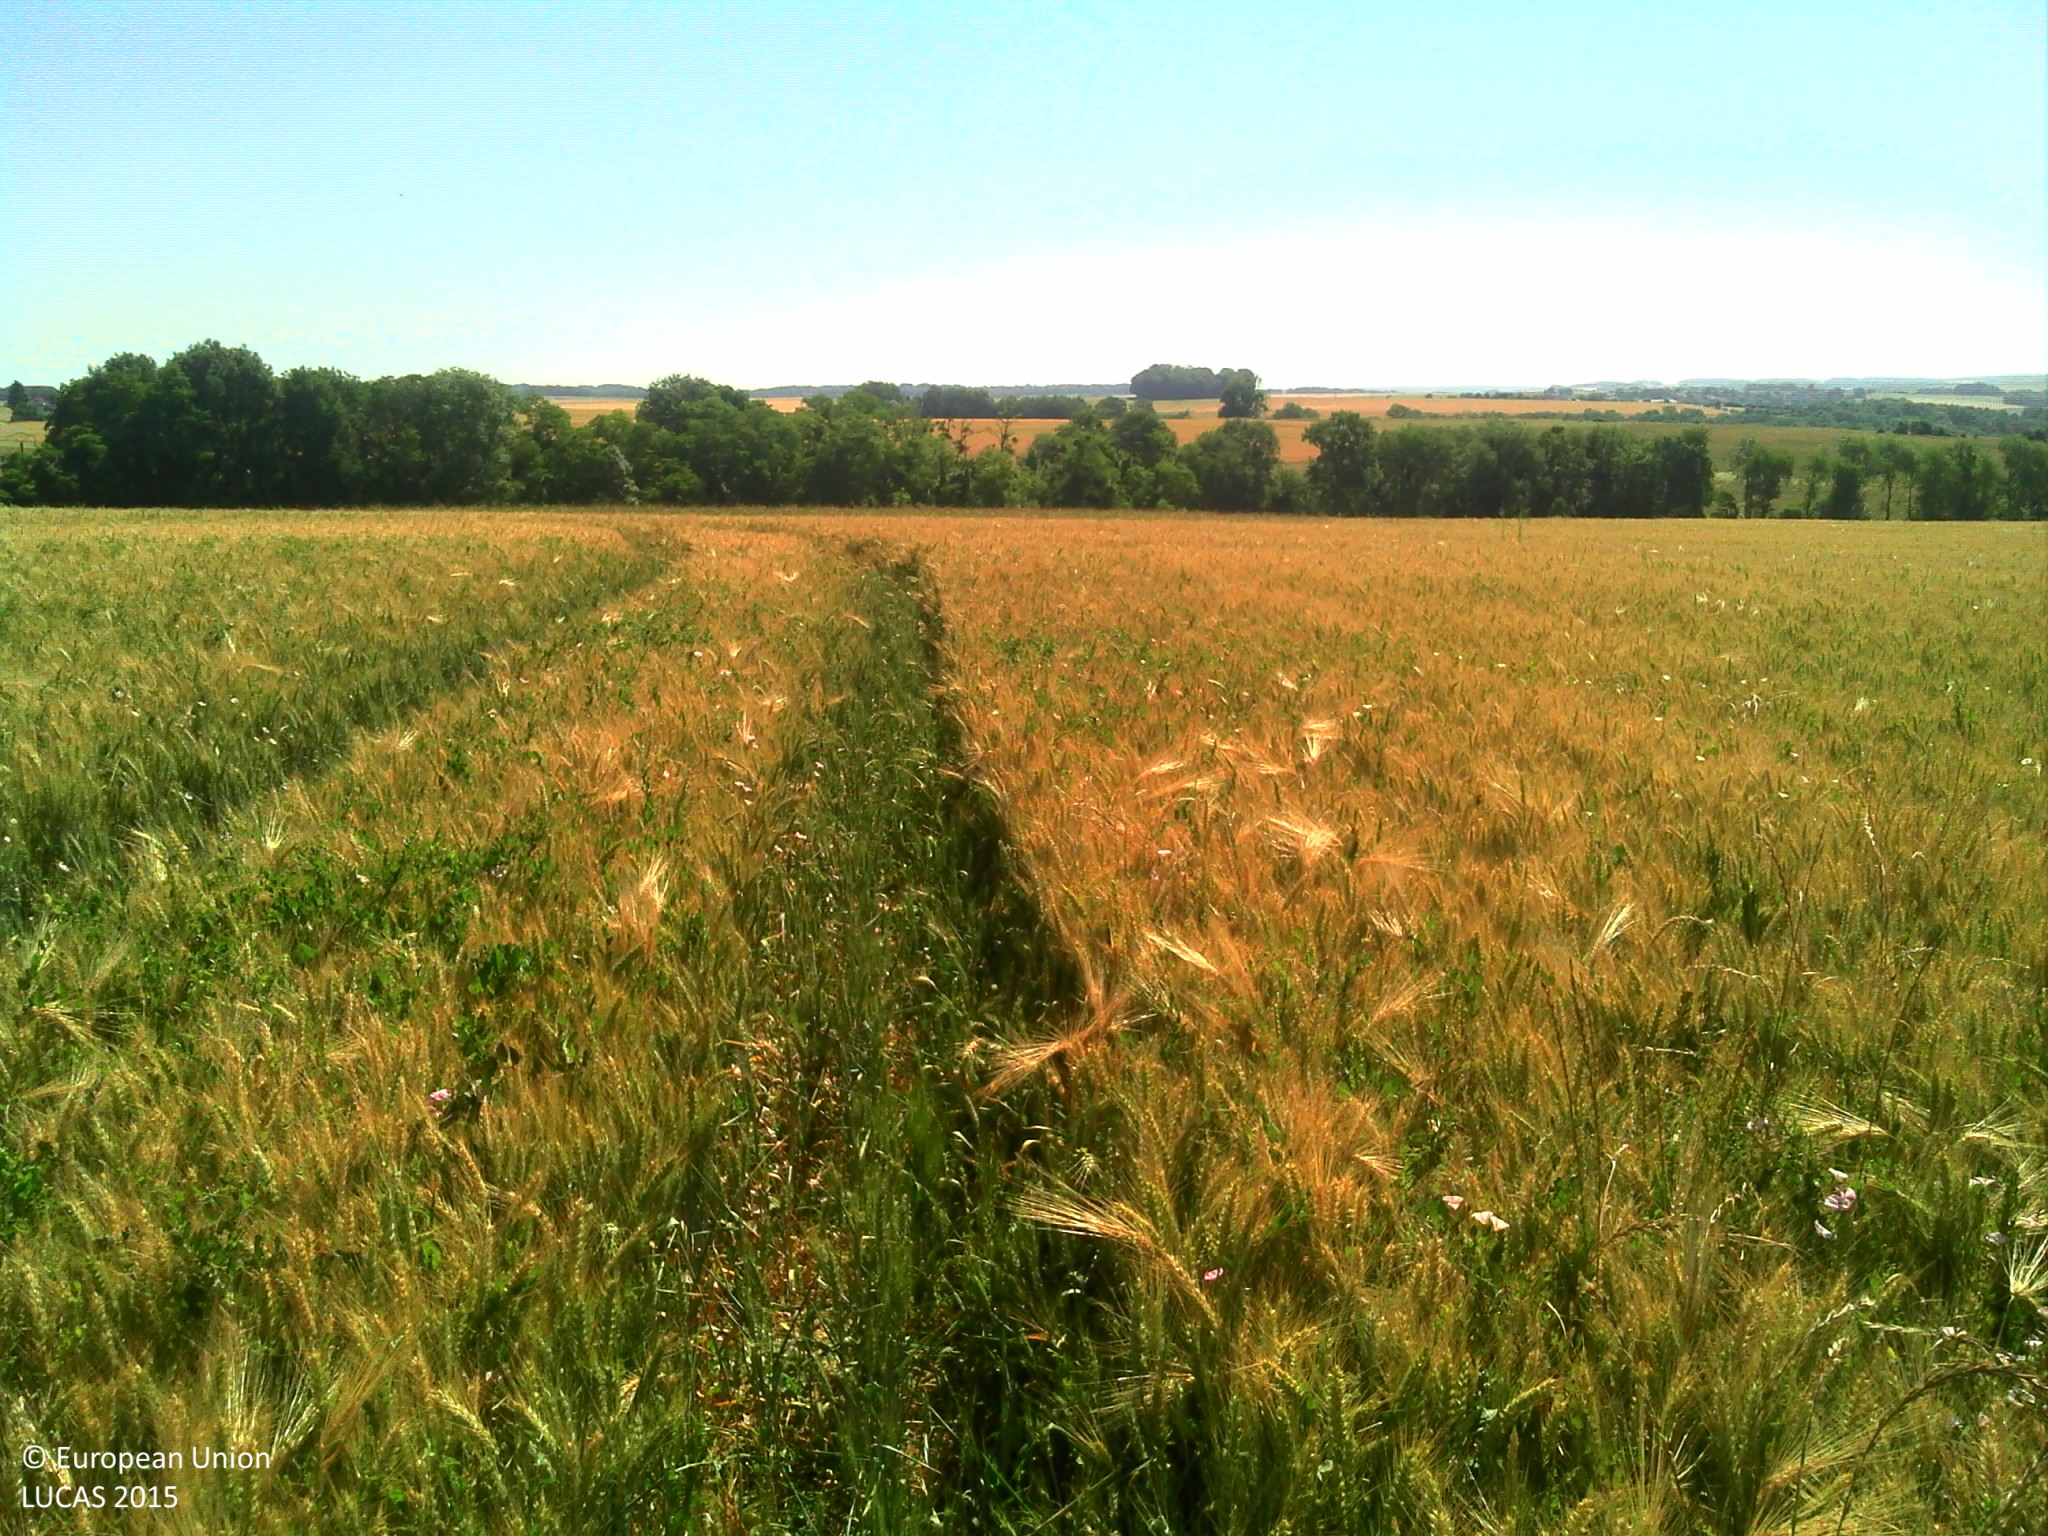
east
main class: Cropland
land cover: Common wheat
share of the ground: > 75 %
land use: Agriculture (excluding fallow land and kitchen gardens)
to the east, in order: Common wheat
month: June
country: FR
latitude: 48.8746
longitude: 3.4076
